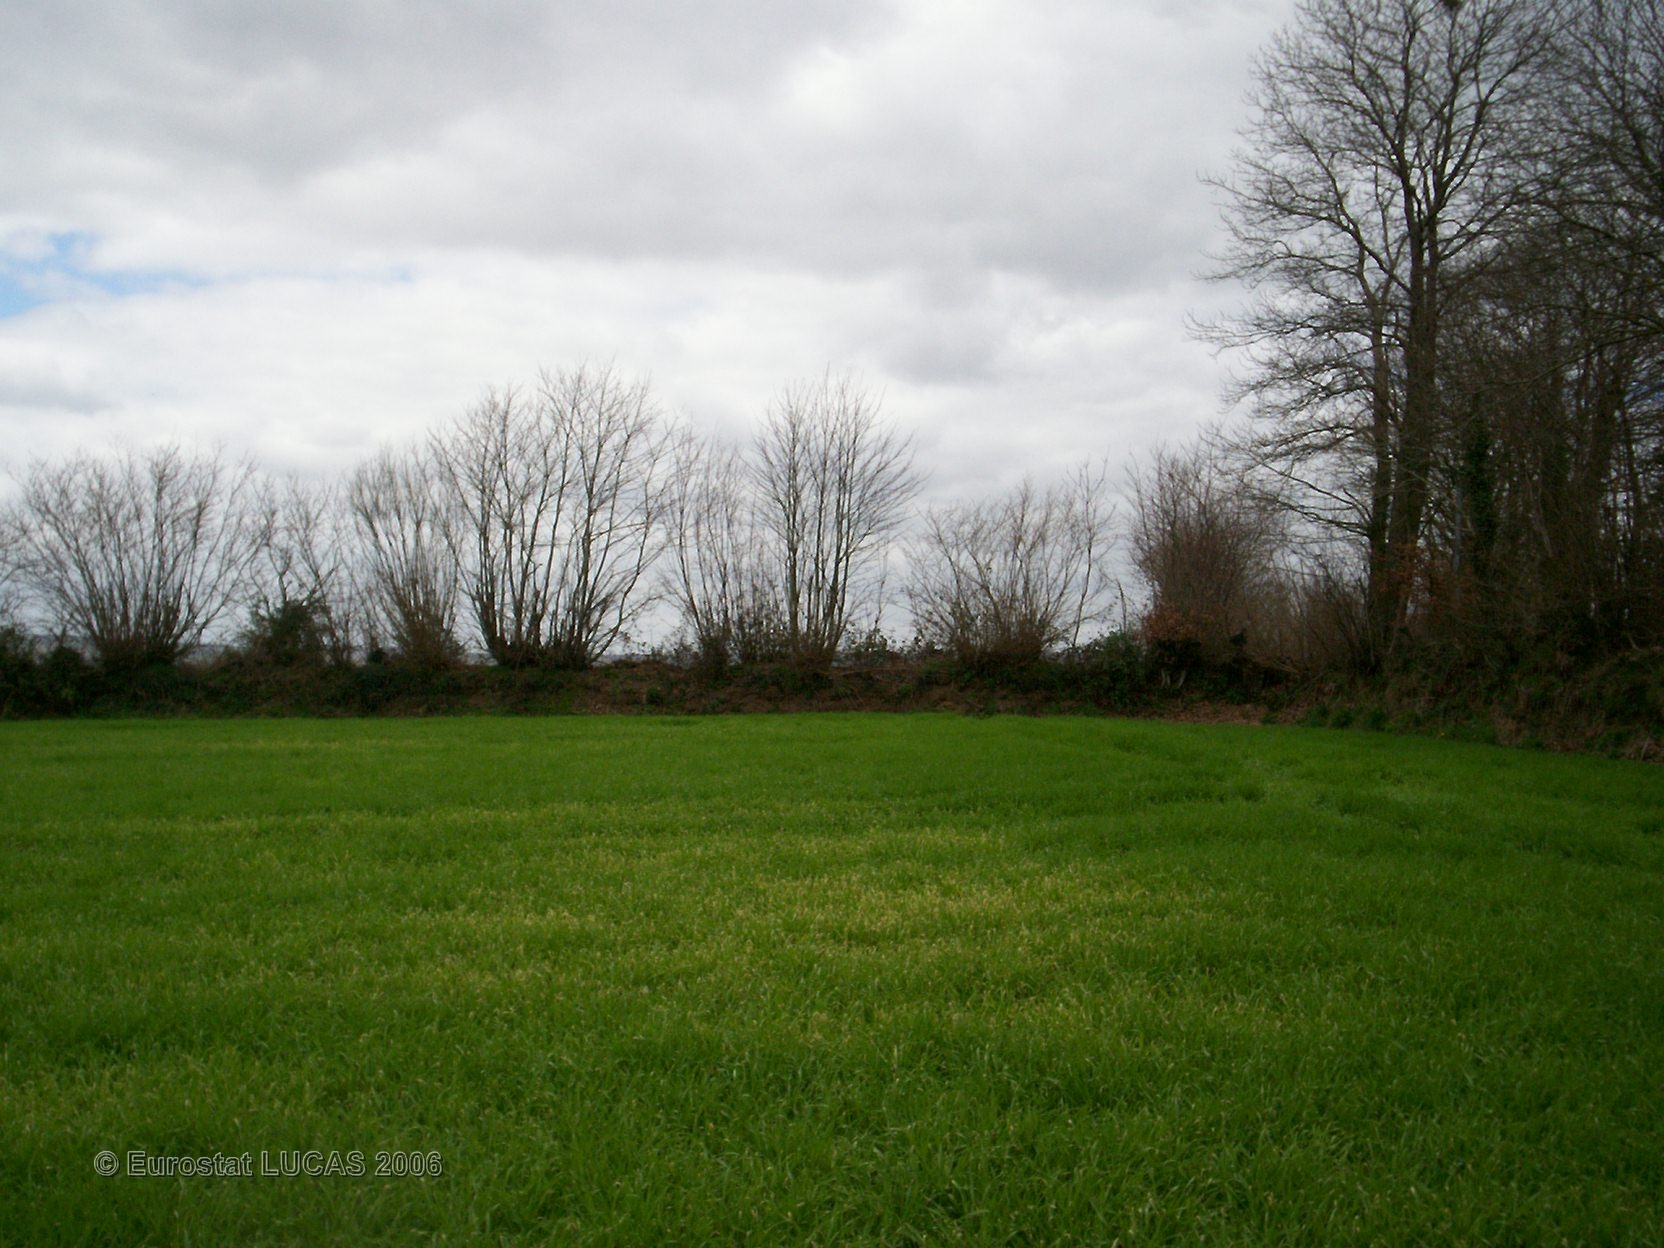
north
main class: Cropland
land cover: Barley
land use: Agriculture (excluding fallow land and kitchen gardens)
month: April
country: FR
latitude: 48.1053
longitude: -3.6030
